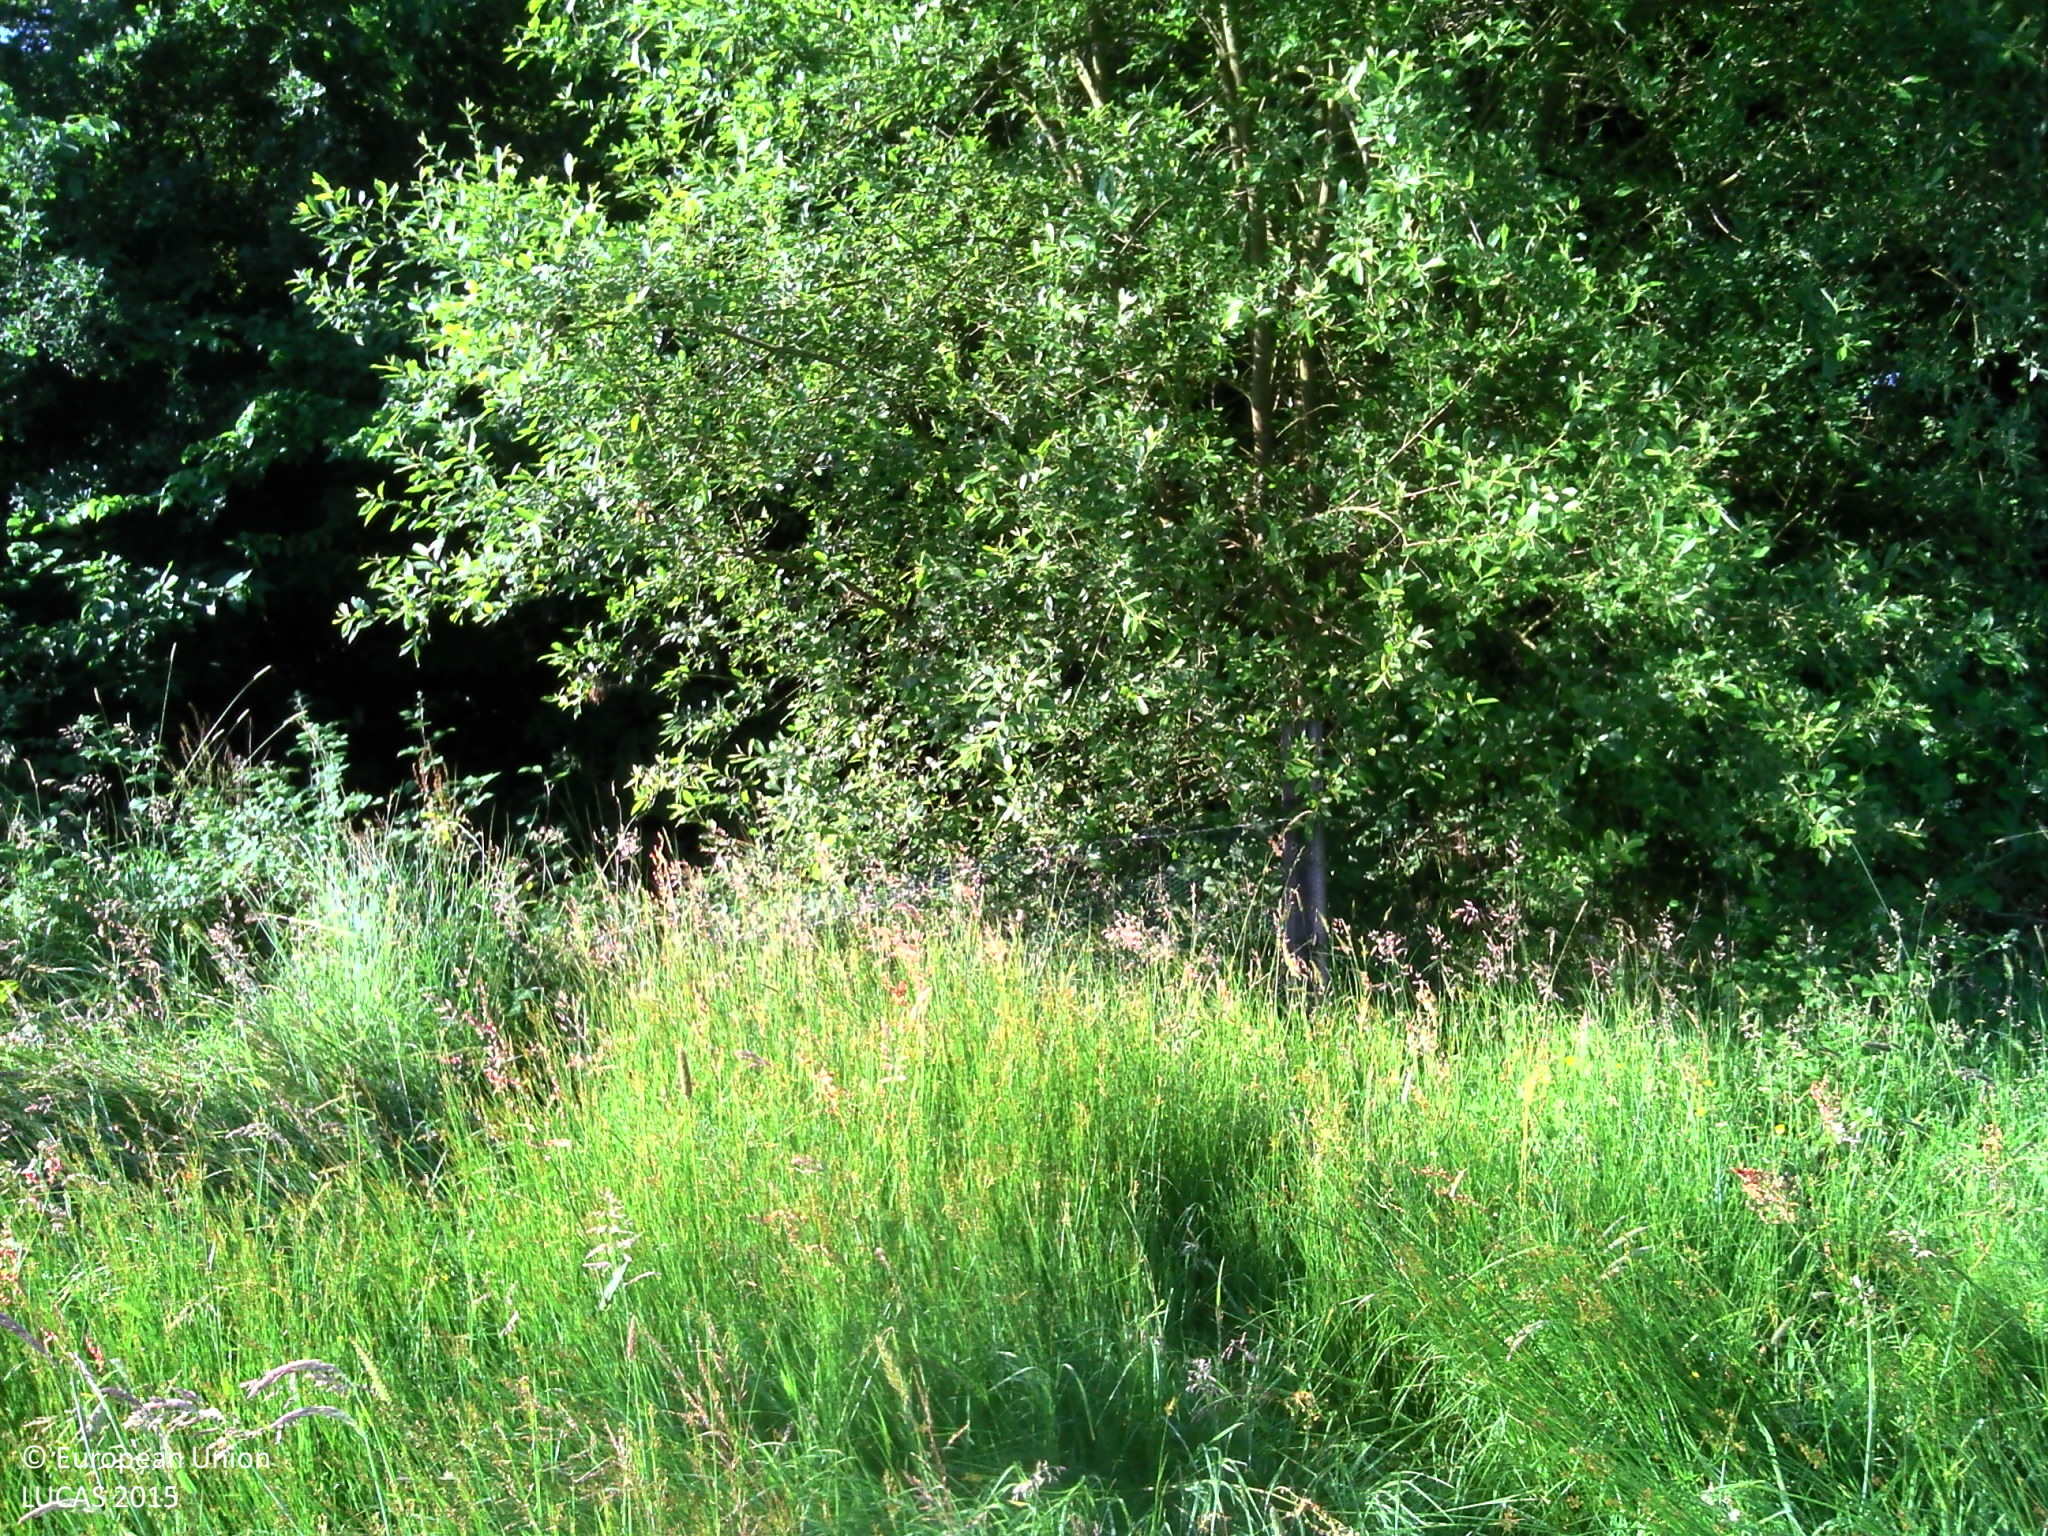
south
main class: Grassland
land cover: Grassland without tree/shrub cover
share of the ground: > 75 %
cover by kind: herbaceous plants 100 %
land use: Agriculture (excluding fallow land and kitchen gardens)
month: June
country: FR
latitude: 49.1056
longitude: 0.3705
